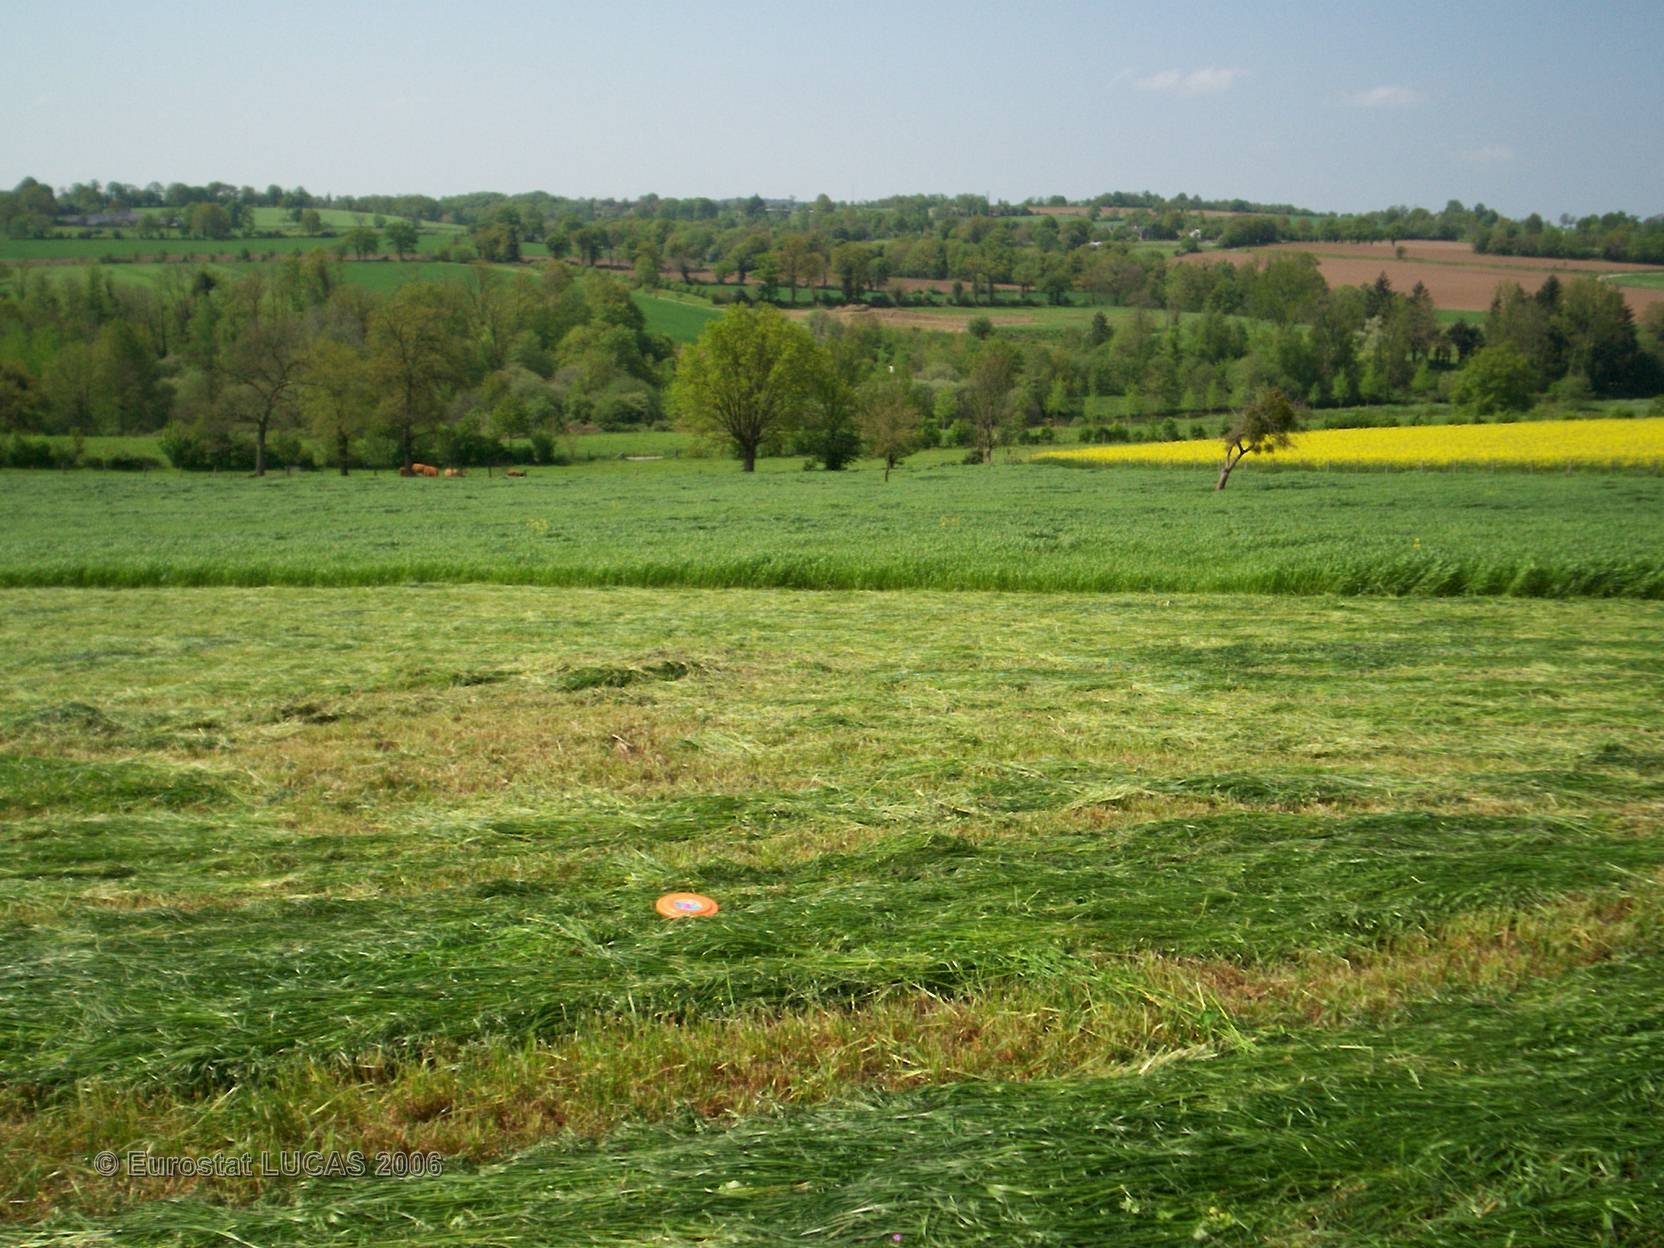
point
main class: Grassland
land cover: Grassland without tree/shrub cover
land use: Agriculture (excluding fallow land and kitchen gardens)
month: May
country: FR
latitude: 48.3041
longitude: -1.3831
